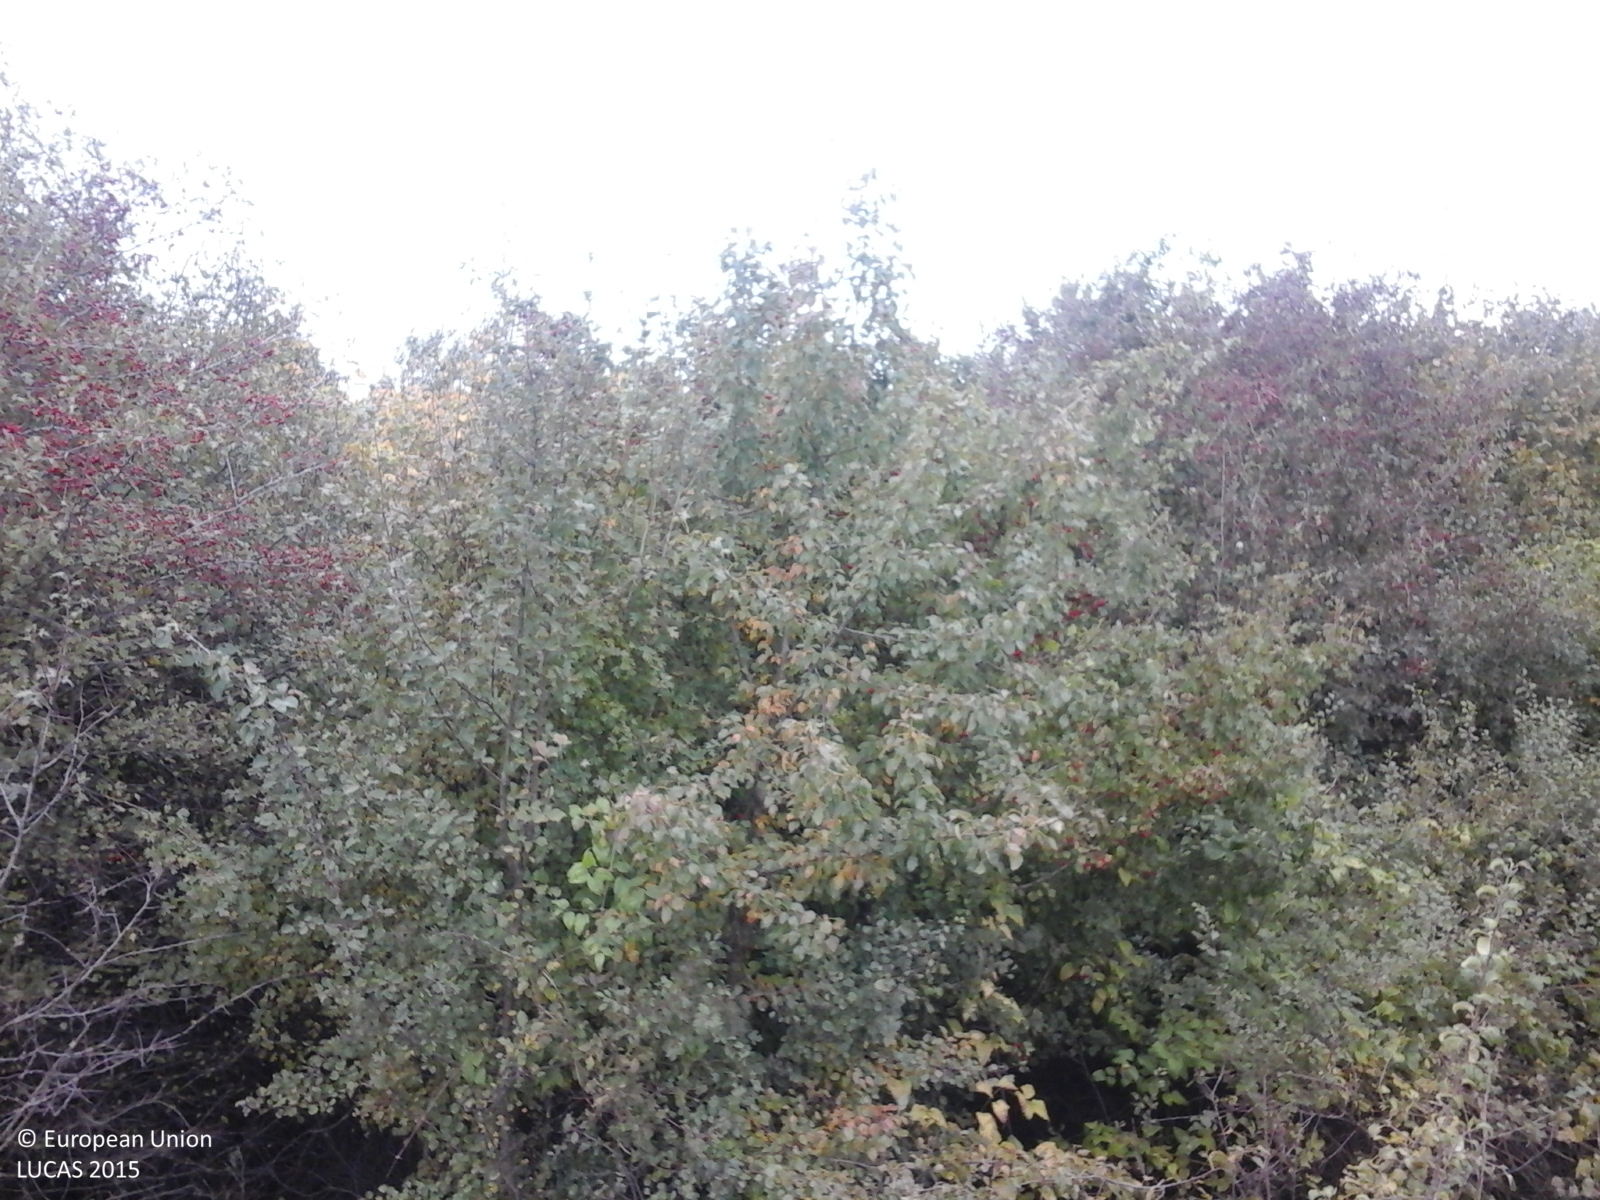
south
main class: Grassland
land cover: Grassland with sparse tree/shrub cover
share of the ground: > 75 %
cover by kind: herbaceous plants 85 %, shrubs 10 %, broadleaved forest trees 5 %
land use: Agriculture (excluding fallow land and kitchen gardens)
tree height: < 5 m
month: October
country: RO
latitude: 46.2343
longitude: 25.1539
